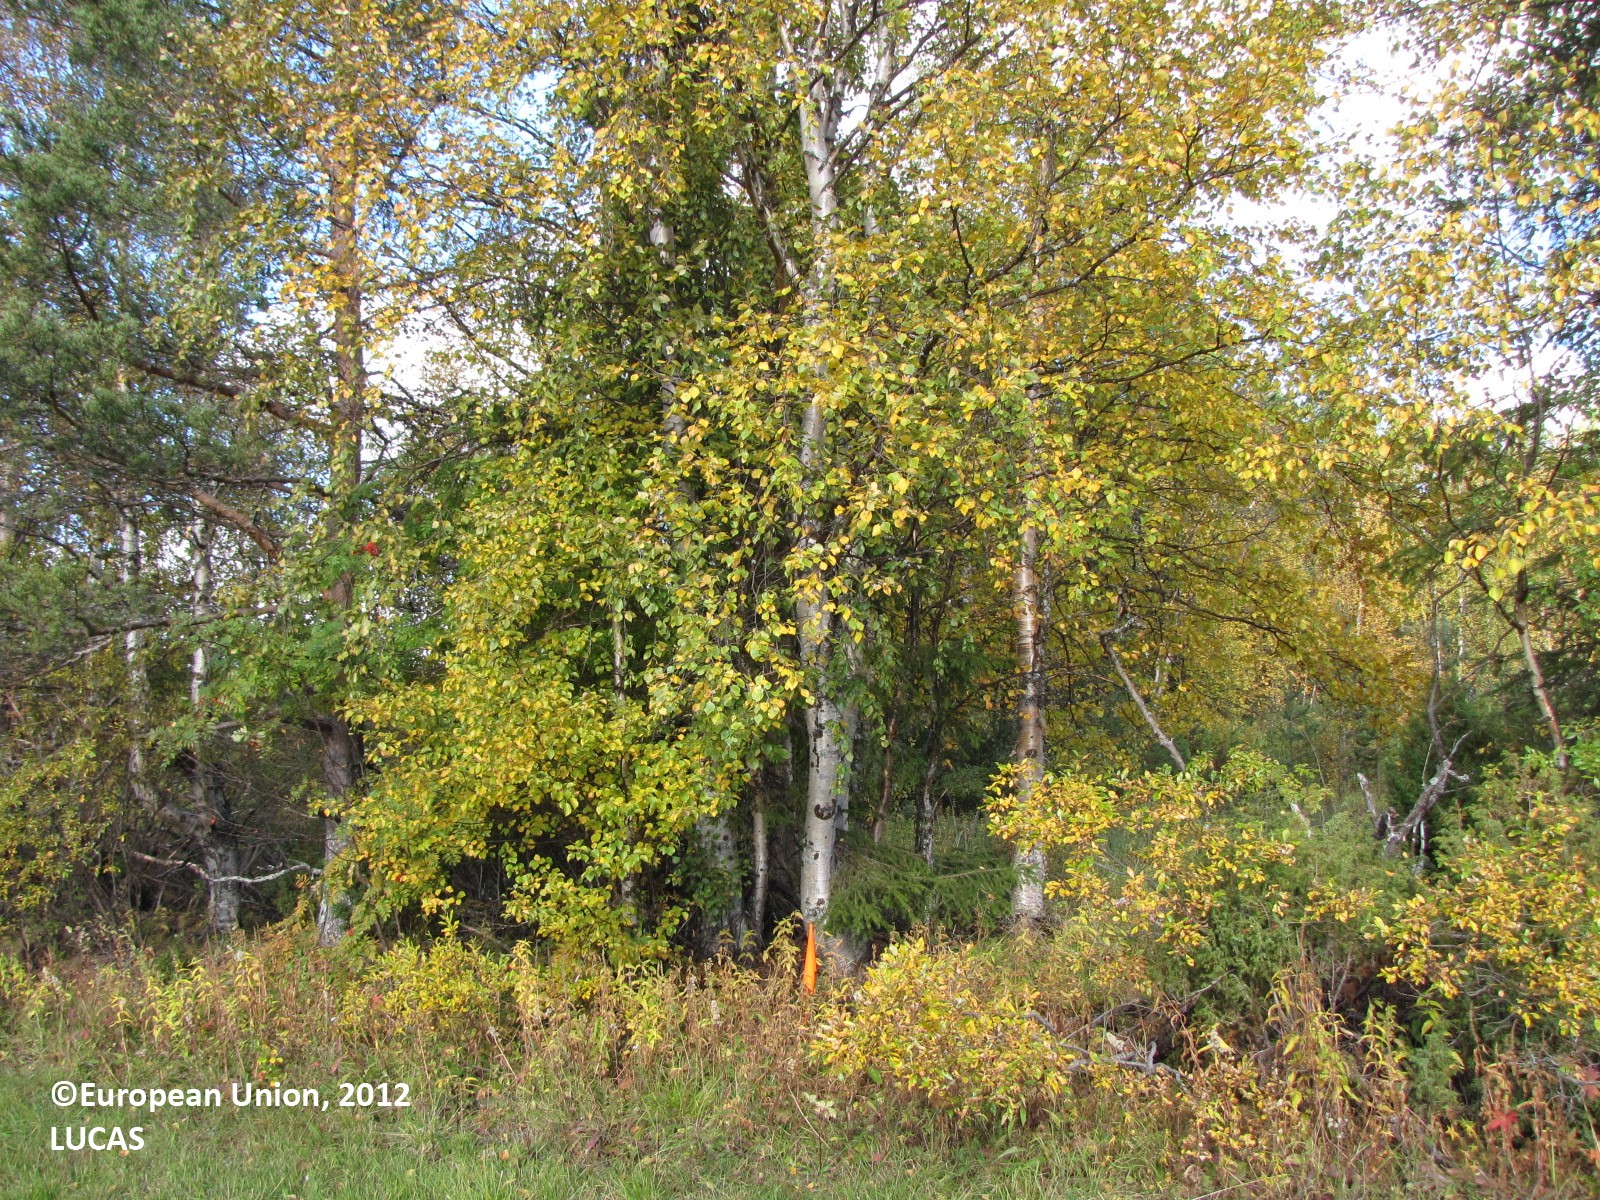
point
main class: Woodland
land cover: Pine dominated mixed woodland
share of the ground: 10 - 25 %
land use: Forestry
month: September
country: FI
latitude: 67.3706
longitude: 24.8745
